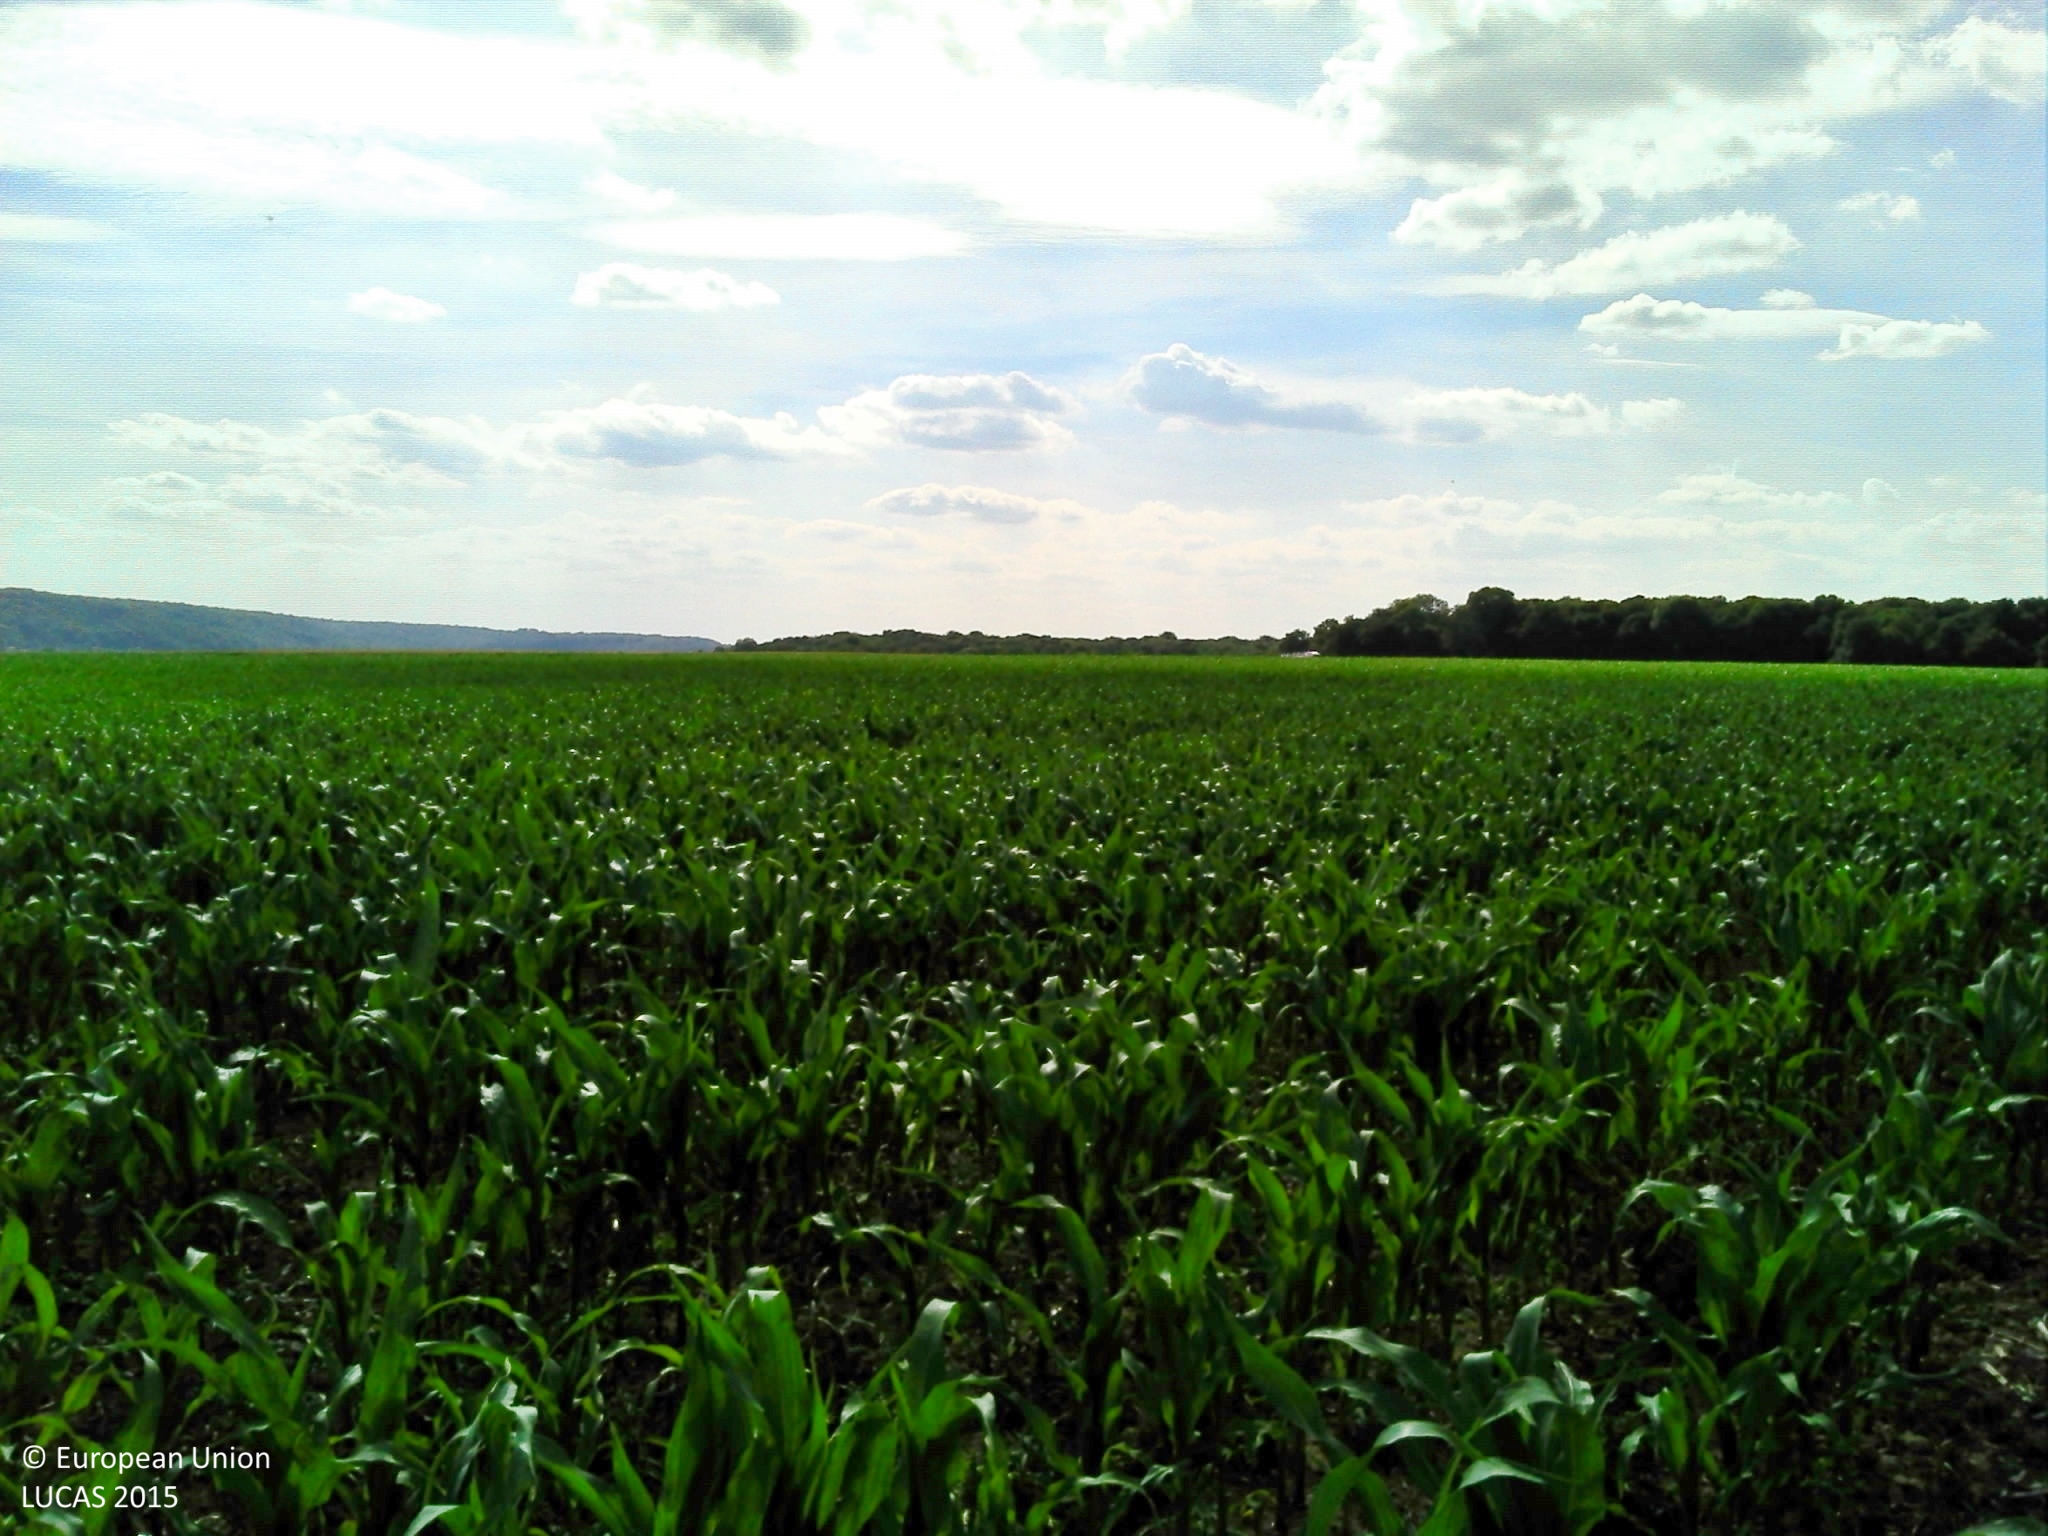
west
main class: Cropland
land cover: Maize
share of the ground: 50 - 75 %
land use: Agriculture (excluding fallow land and kitchen gardens)
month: June
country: FR
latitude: 49.3814
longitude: 2.5639
